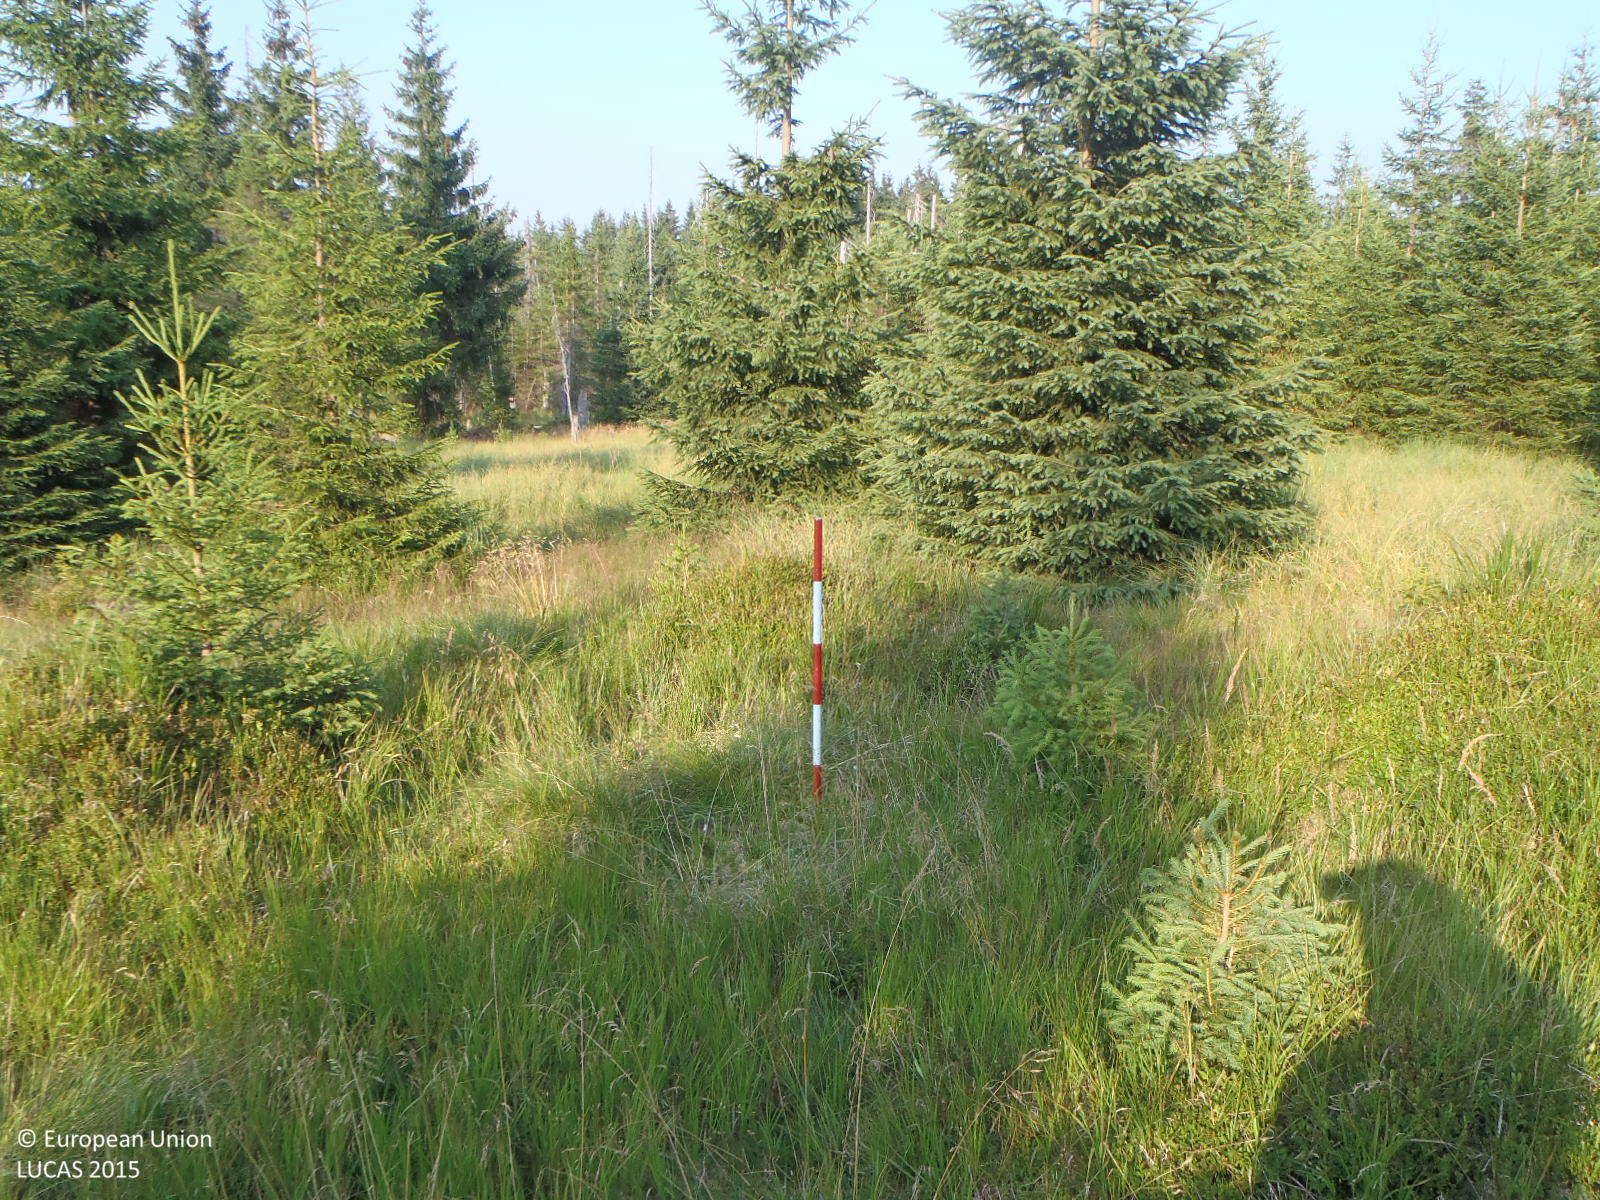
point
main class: Woodland
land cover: Spruce dominated coniferous woodland
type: mire and swamp forests
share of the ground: 25 - 50 %
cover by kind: coniferous forest trees 40 %, herbaceous plants 30 %, lichens and mosses 20 %, shrubs 10 %
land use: Semi-natural and natural areas not in use
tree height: > 5 m
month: August
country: CZ
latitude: 50.8525
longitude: 15.3305
